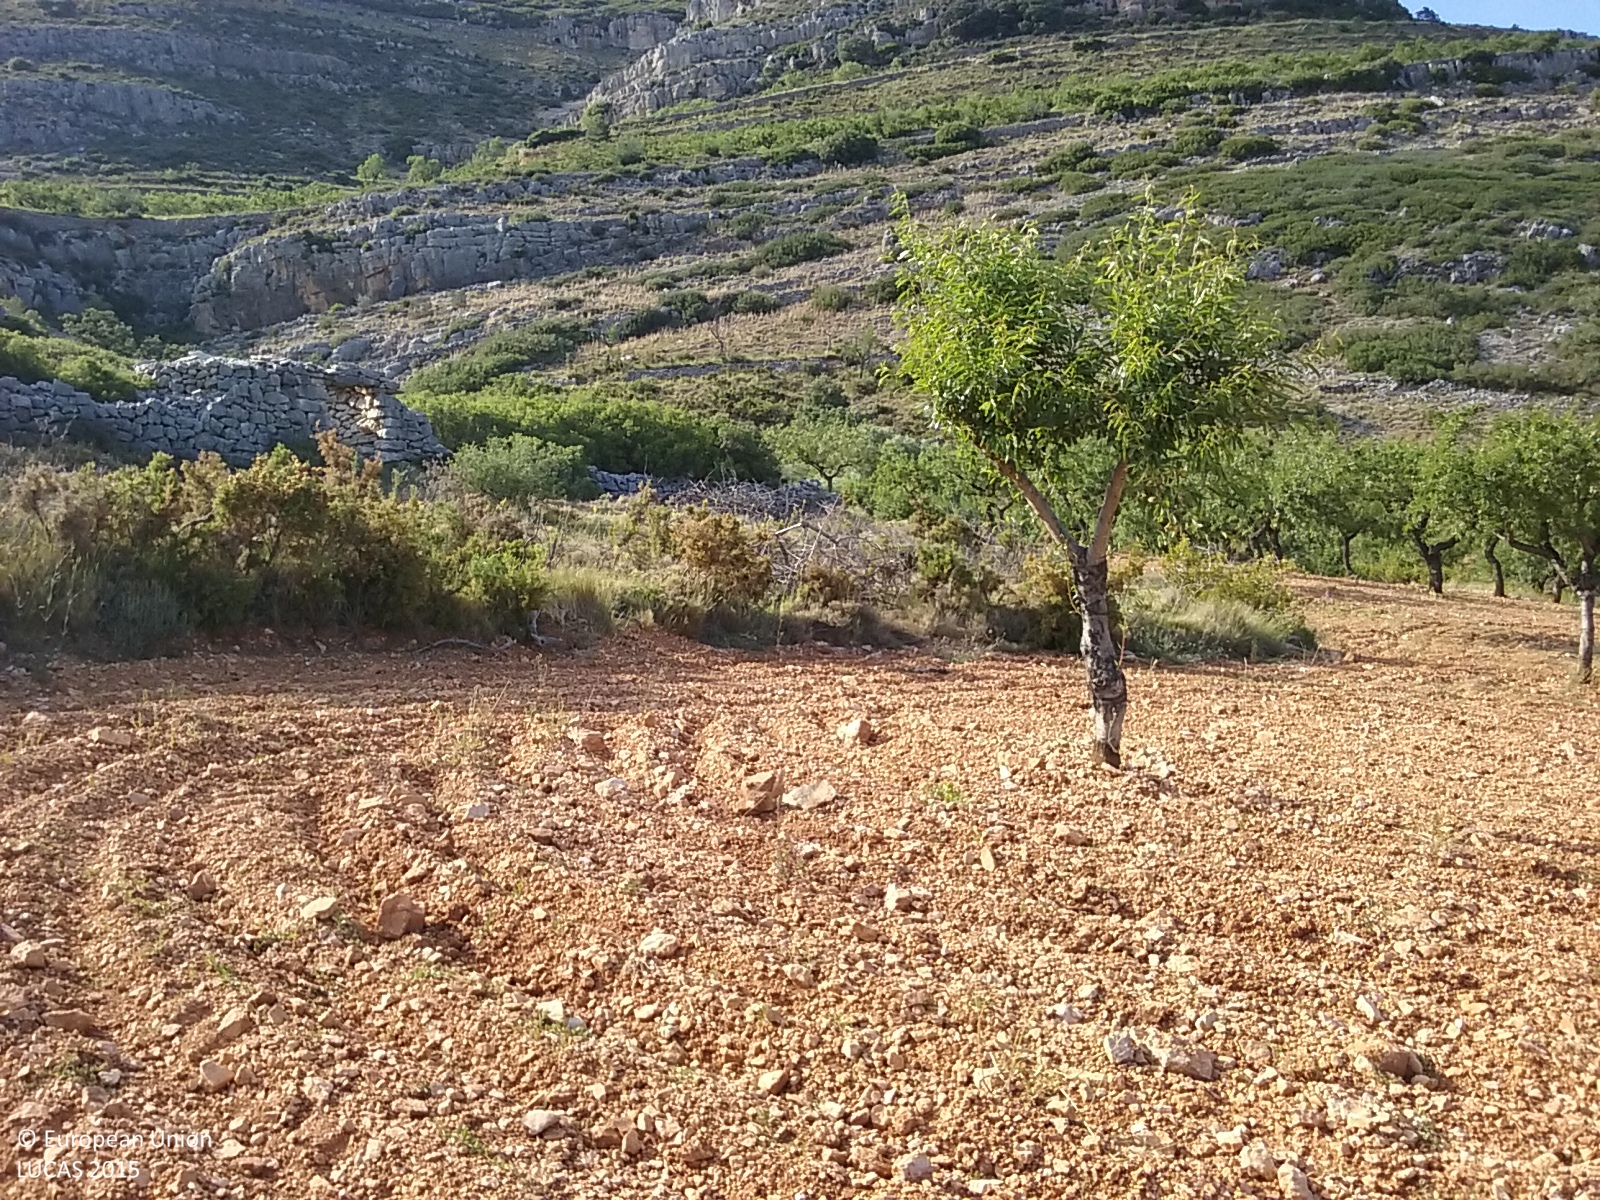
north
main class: Cropland
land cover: Nuts trees
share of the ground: < 10 %
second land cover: Other bare soil
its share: > 75 %
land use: Agriculture (excluding fallow land and kitchen gardens)
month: May
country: ES
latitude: 40.3920
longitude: -0.0067
